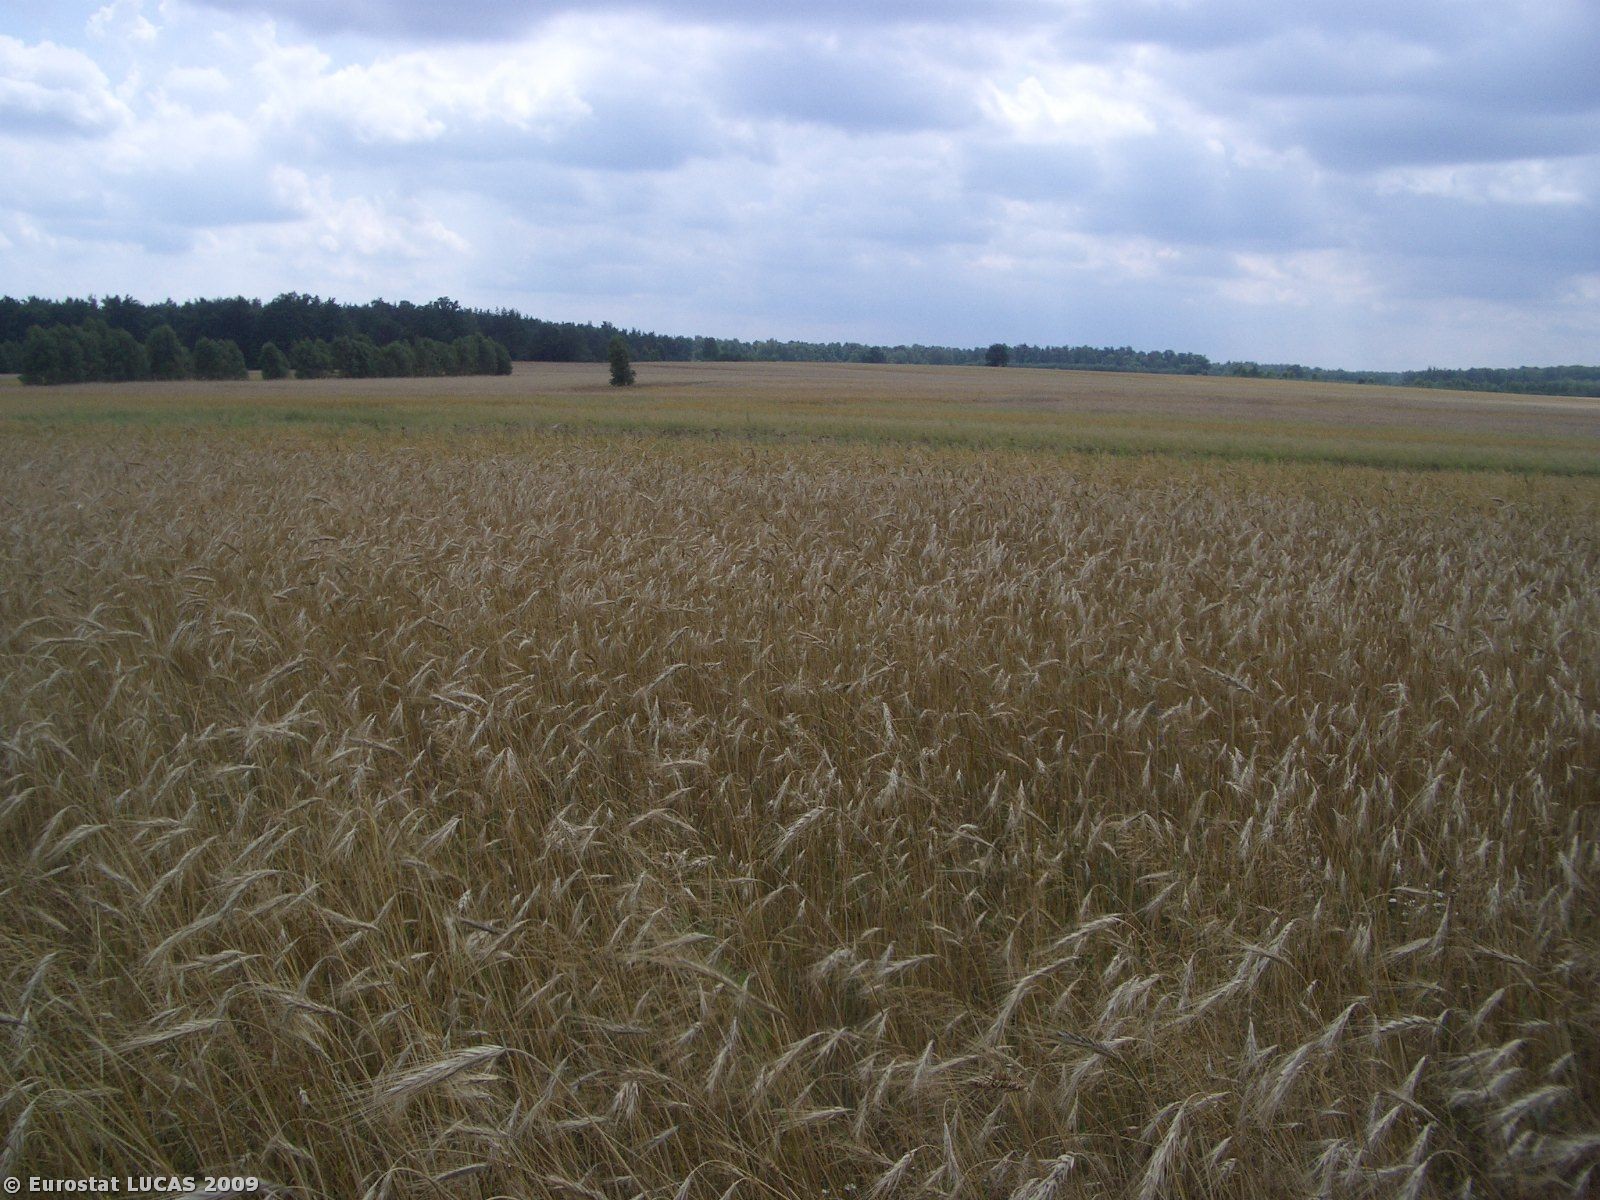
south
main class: Cropland
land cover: Rye
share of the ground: > 75 %
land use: Agriculture (excluding fallow land and kitchen gardens)
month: July
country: PL
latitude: 51.7489
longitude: 22.5090
